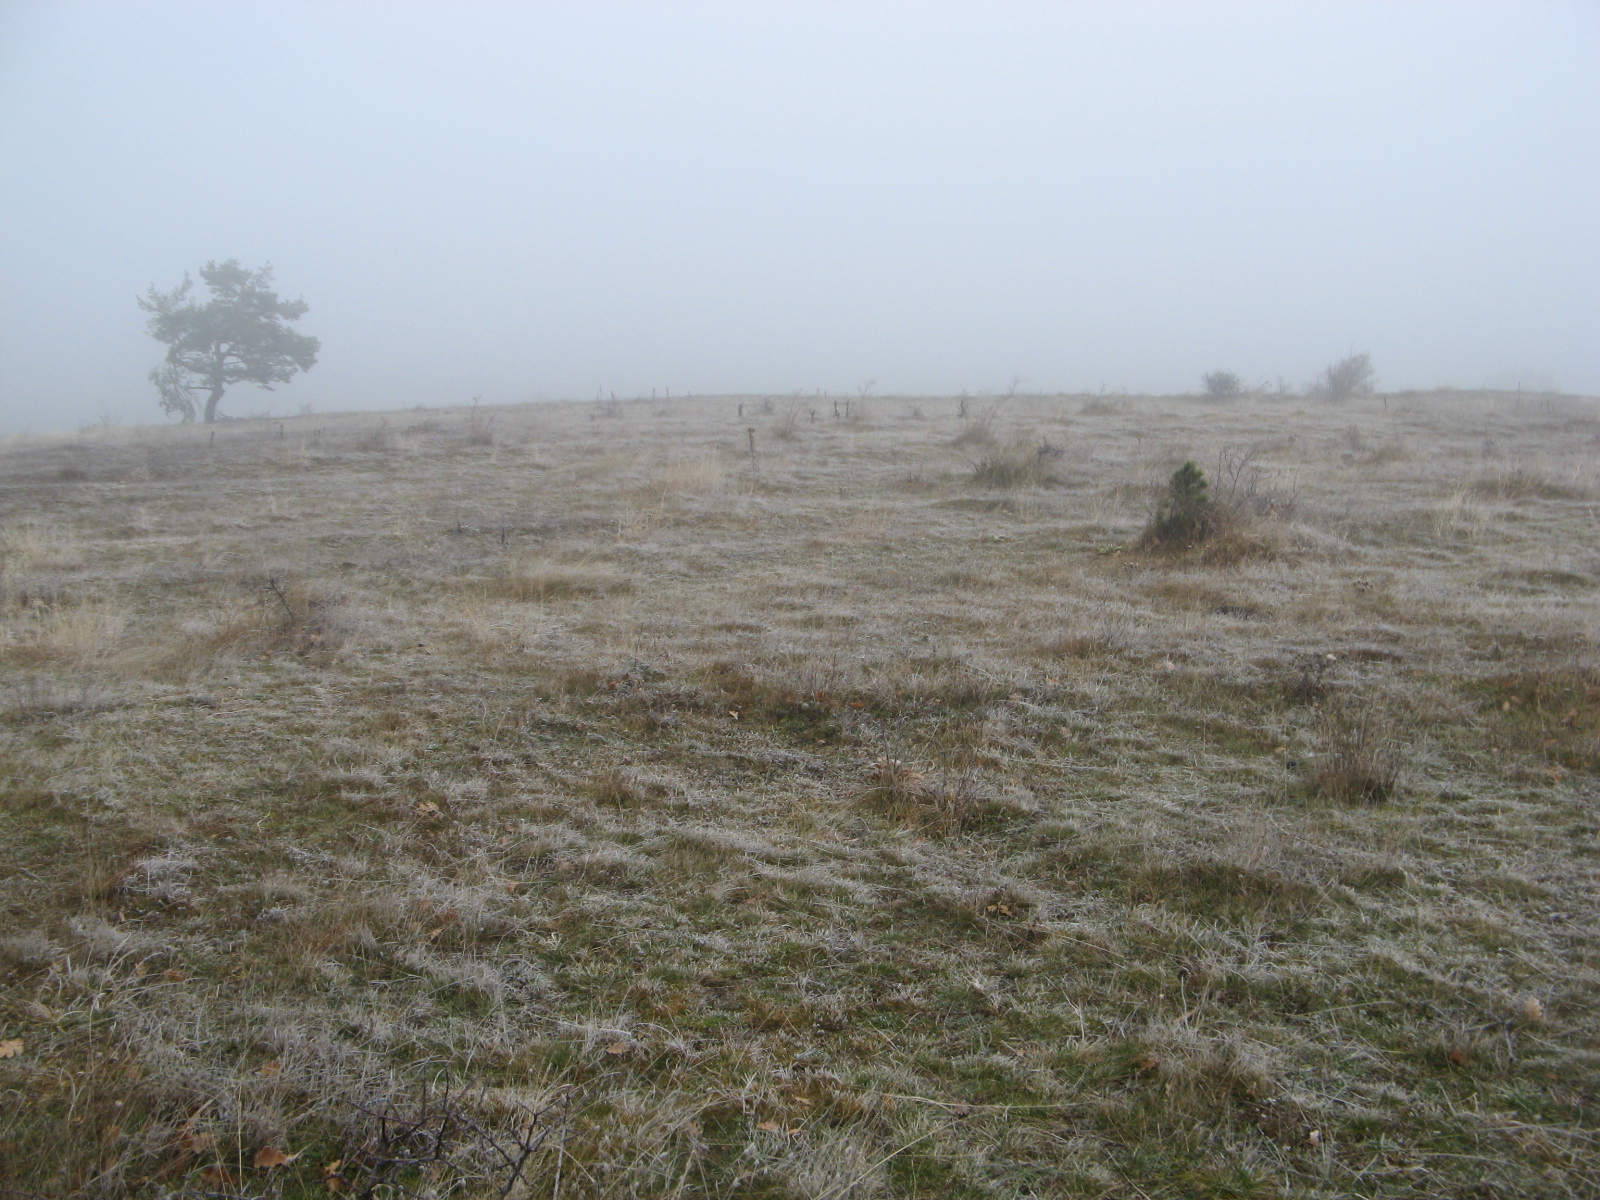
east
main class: Grassland
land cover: Grassland with sparse tree/shrub cover
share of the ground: > 75 %
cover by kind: herbaceous plants 90 %, broadleaved forest trees 5 %, shrubs 5 %
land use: Agriculture (excluding fallow land and kitchen gardens)
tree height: < 5 m
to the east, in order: Grassland with sparse tree/shrub cover; Other structural elements; Grassland without tree/shrub cover; Other structural elements; Grassland without tree/shrub cover; Other structural elements; Grassland without tree/shrub cover; Other structural elements; Grassland without tree/shrub cover; Other structural elements; Grassland without tree/shrub cover; Other structural elements; Grassland without tree/shrub cover
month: December
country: BG
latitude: 42.0622
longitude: 24.1183
